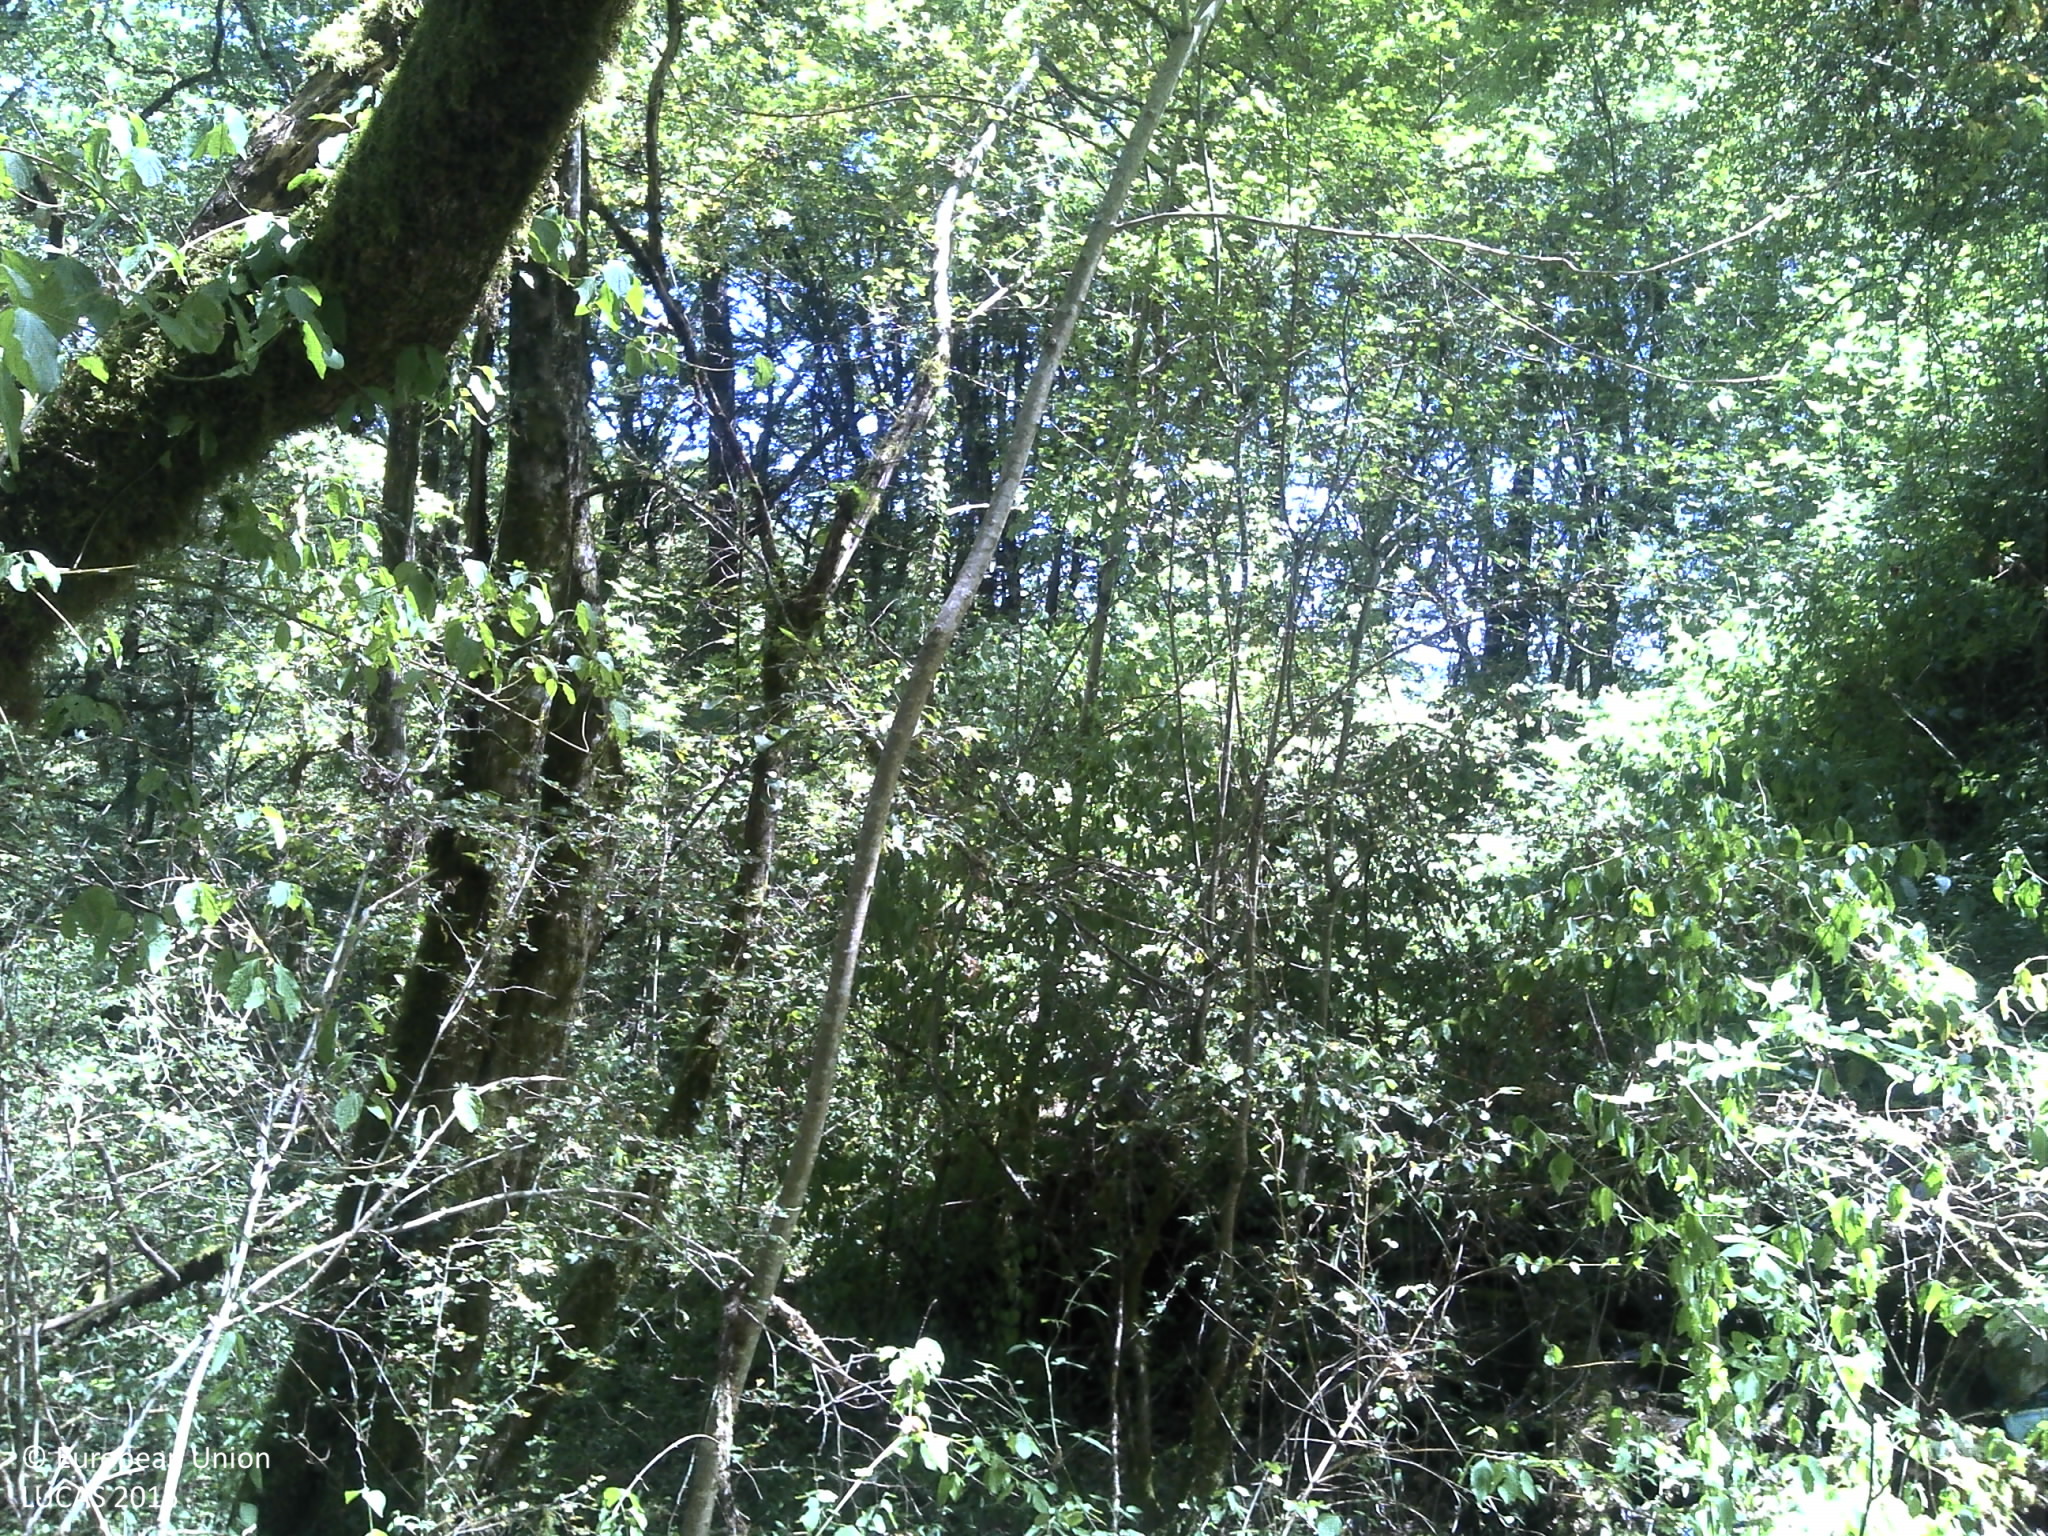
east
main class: Woodland
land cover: Broadleaved woodland
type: thermophilous deciduous forest
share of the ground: > 75 %
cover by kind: broadleaved forest trees 65 %, herbaceous plants 20 %, unconsolidated bare surface 5 %
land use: Abandoned areas
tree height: > 5 m
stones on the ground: < 10 %
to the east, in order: Broadleaved woodland; Fences; Grassland without tree/shrub cover; Abandoned hedges; Fences; Grassland without tree/shrub cover
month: July
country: FR
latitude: 45.0528
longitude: 1.7307
